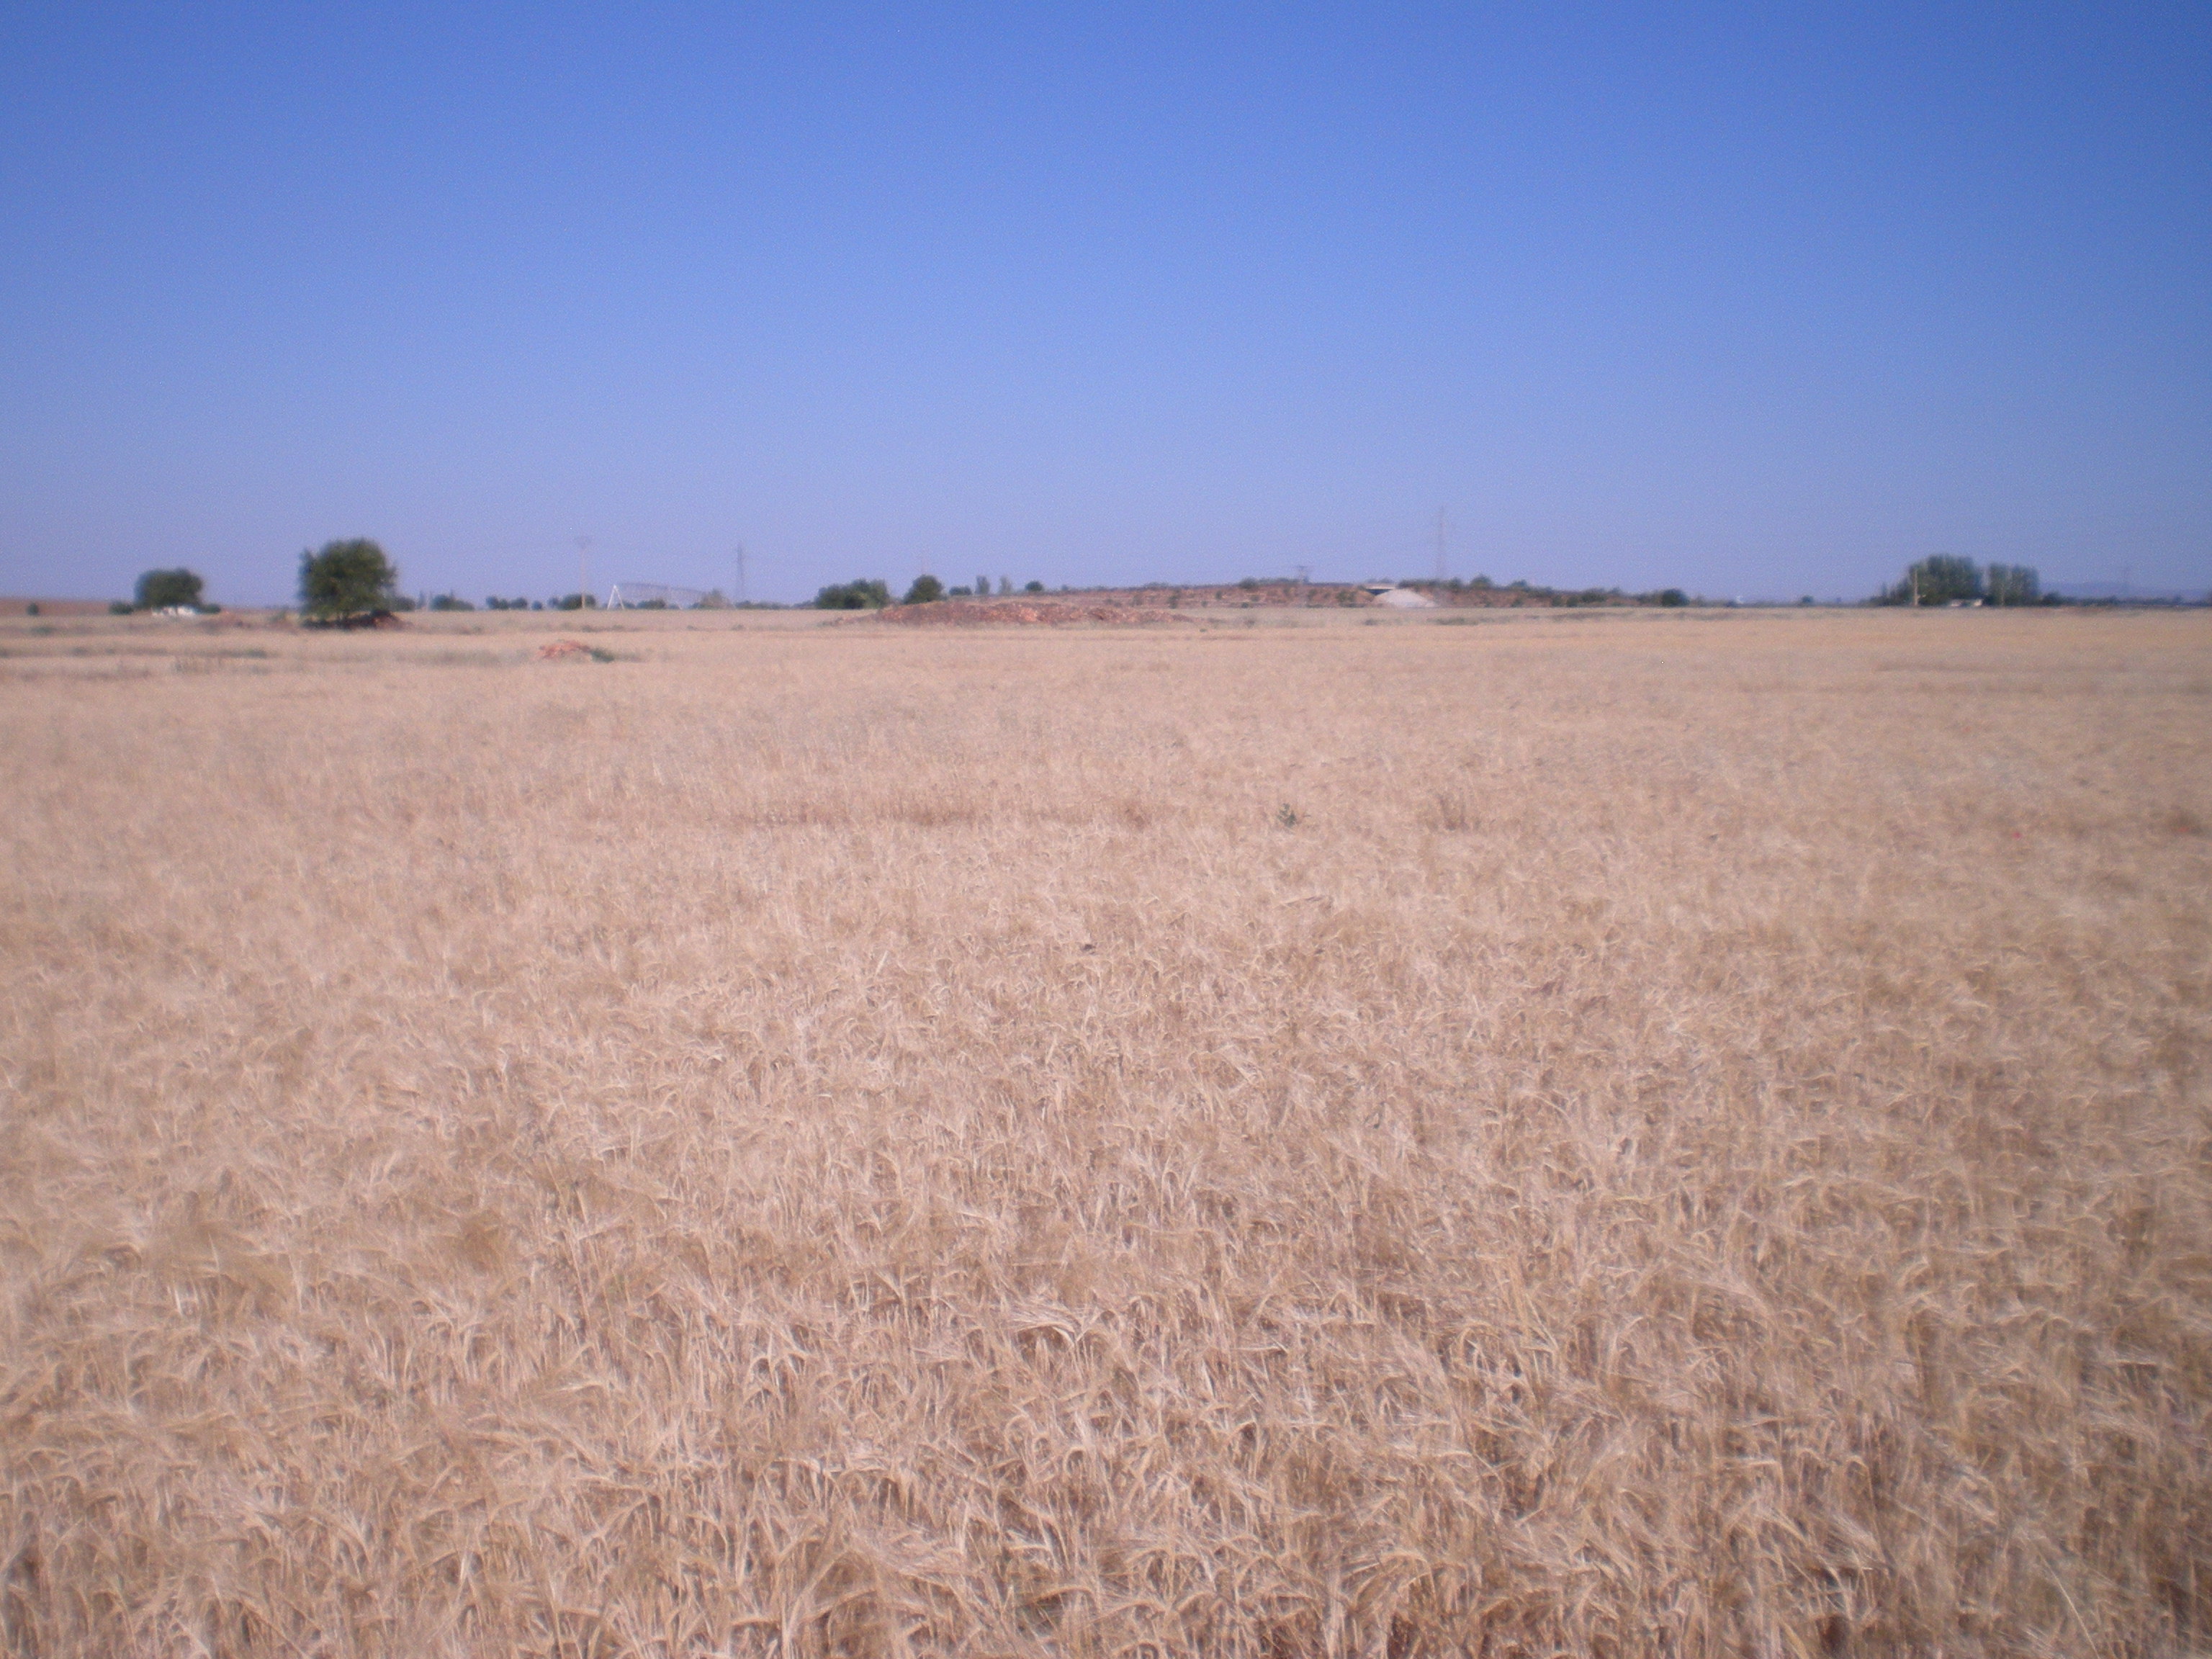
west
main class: Cropland
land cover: Barley
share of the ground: > 75 %
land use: Agriculture (excluding fallow land and kitchen gardens)
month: May
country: ES
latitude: 39.0384
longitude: -3.6153
